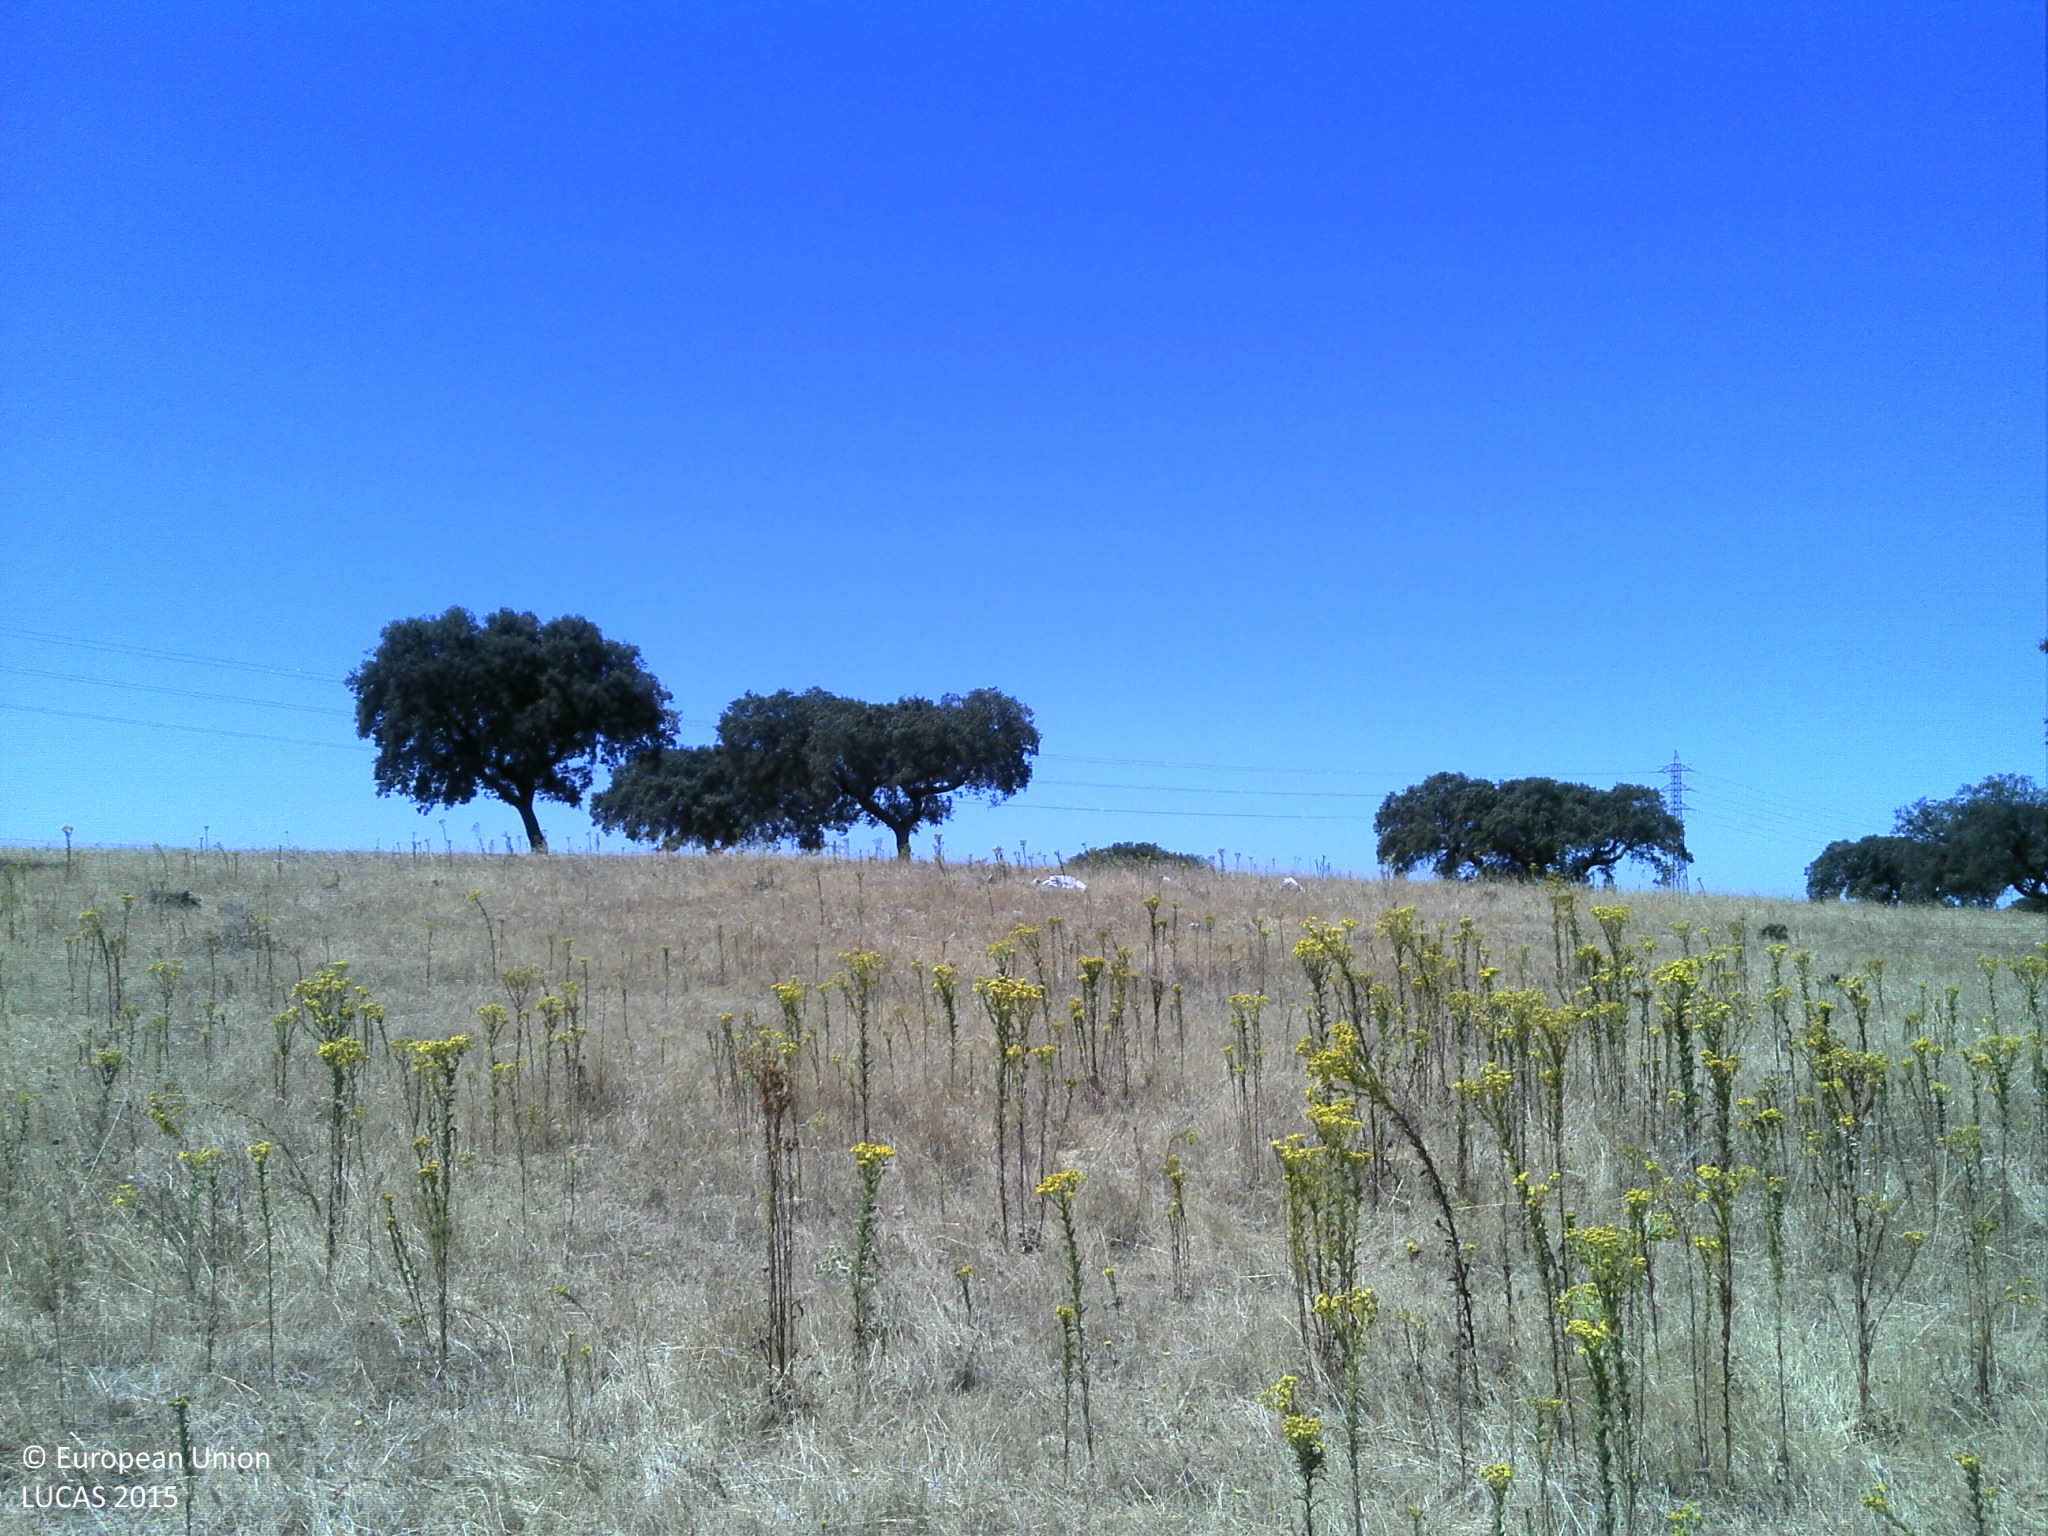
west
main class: Grassland
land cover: Grassland without tree/shrub cover
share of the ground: 25 - 50 %
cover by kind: unconsolidated bare surface 70 %, herbaceous plants 30 %
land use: Agriculture (excluding fallow land and kitchen gardens)
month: July
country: PT
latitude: 38.8784
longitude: -7.4281
